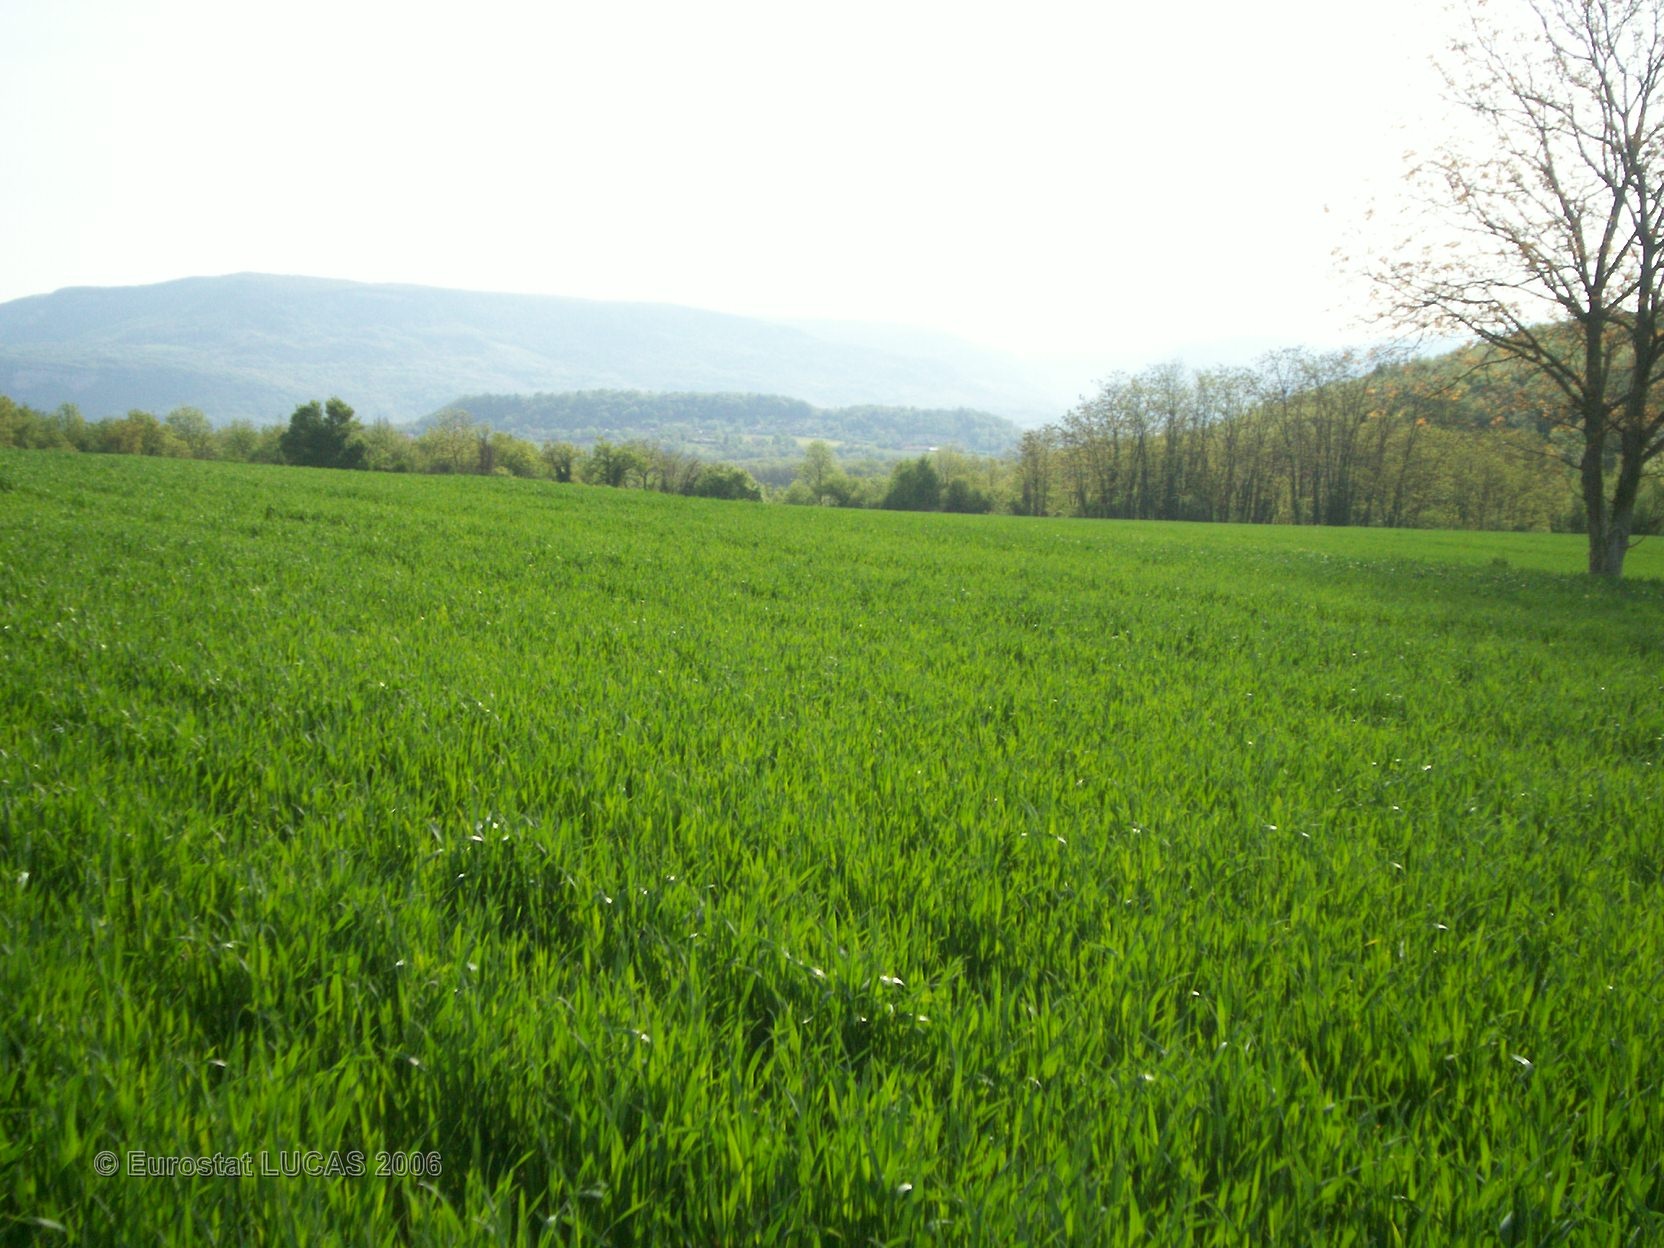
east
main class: Cropland
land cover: Common wheat
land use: Agriculture (excluding fallow land and kitchen gardens)
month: May
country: FR
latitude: 45.7837
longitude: 5.4121
